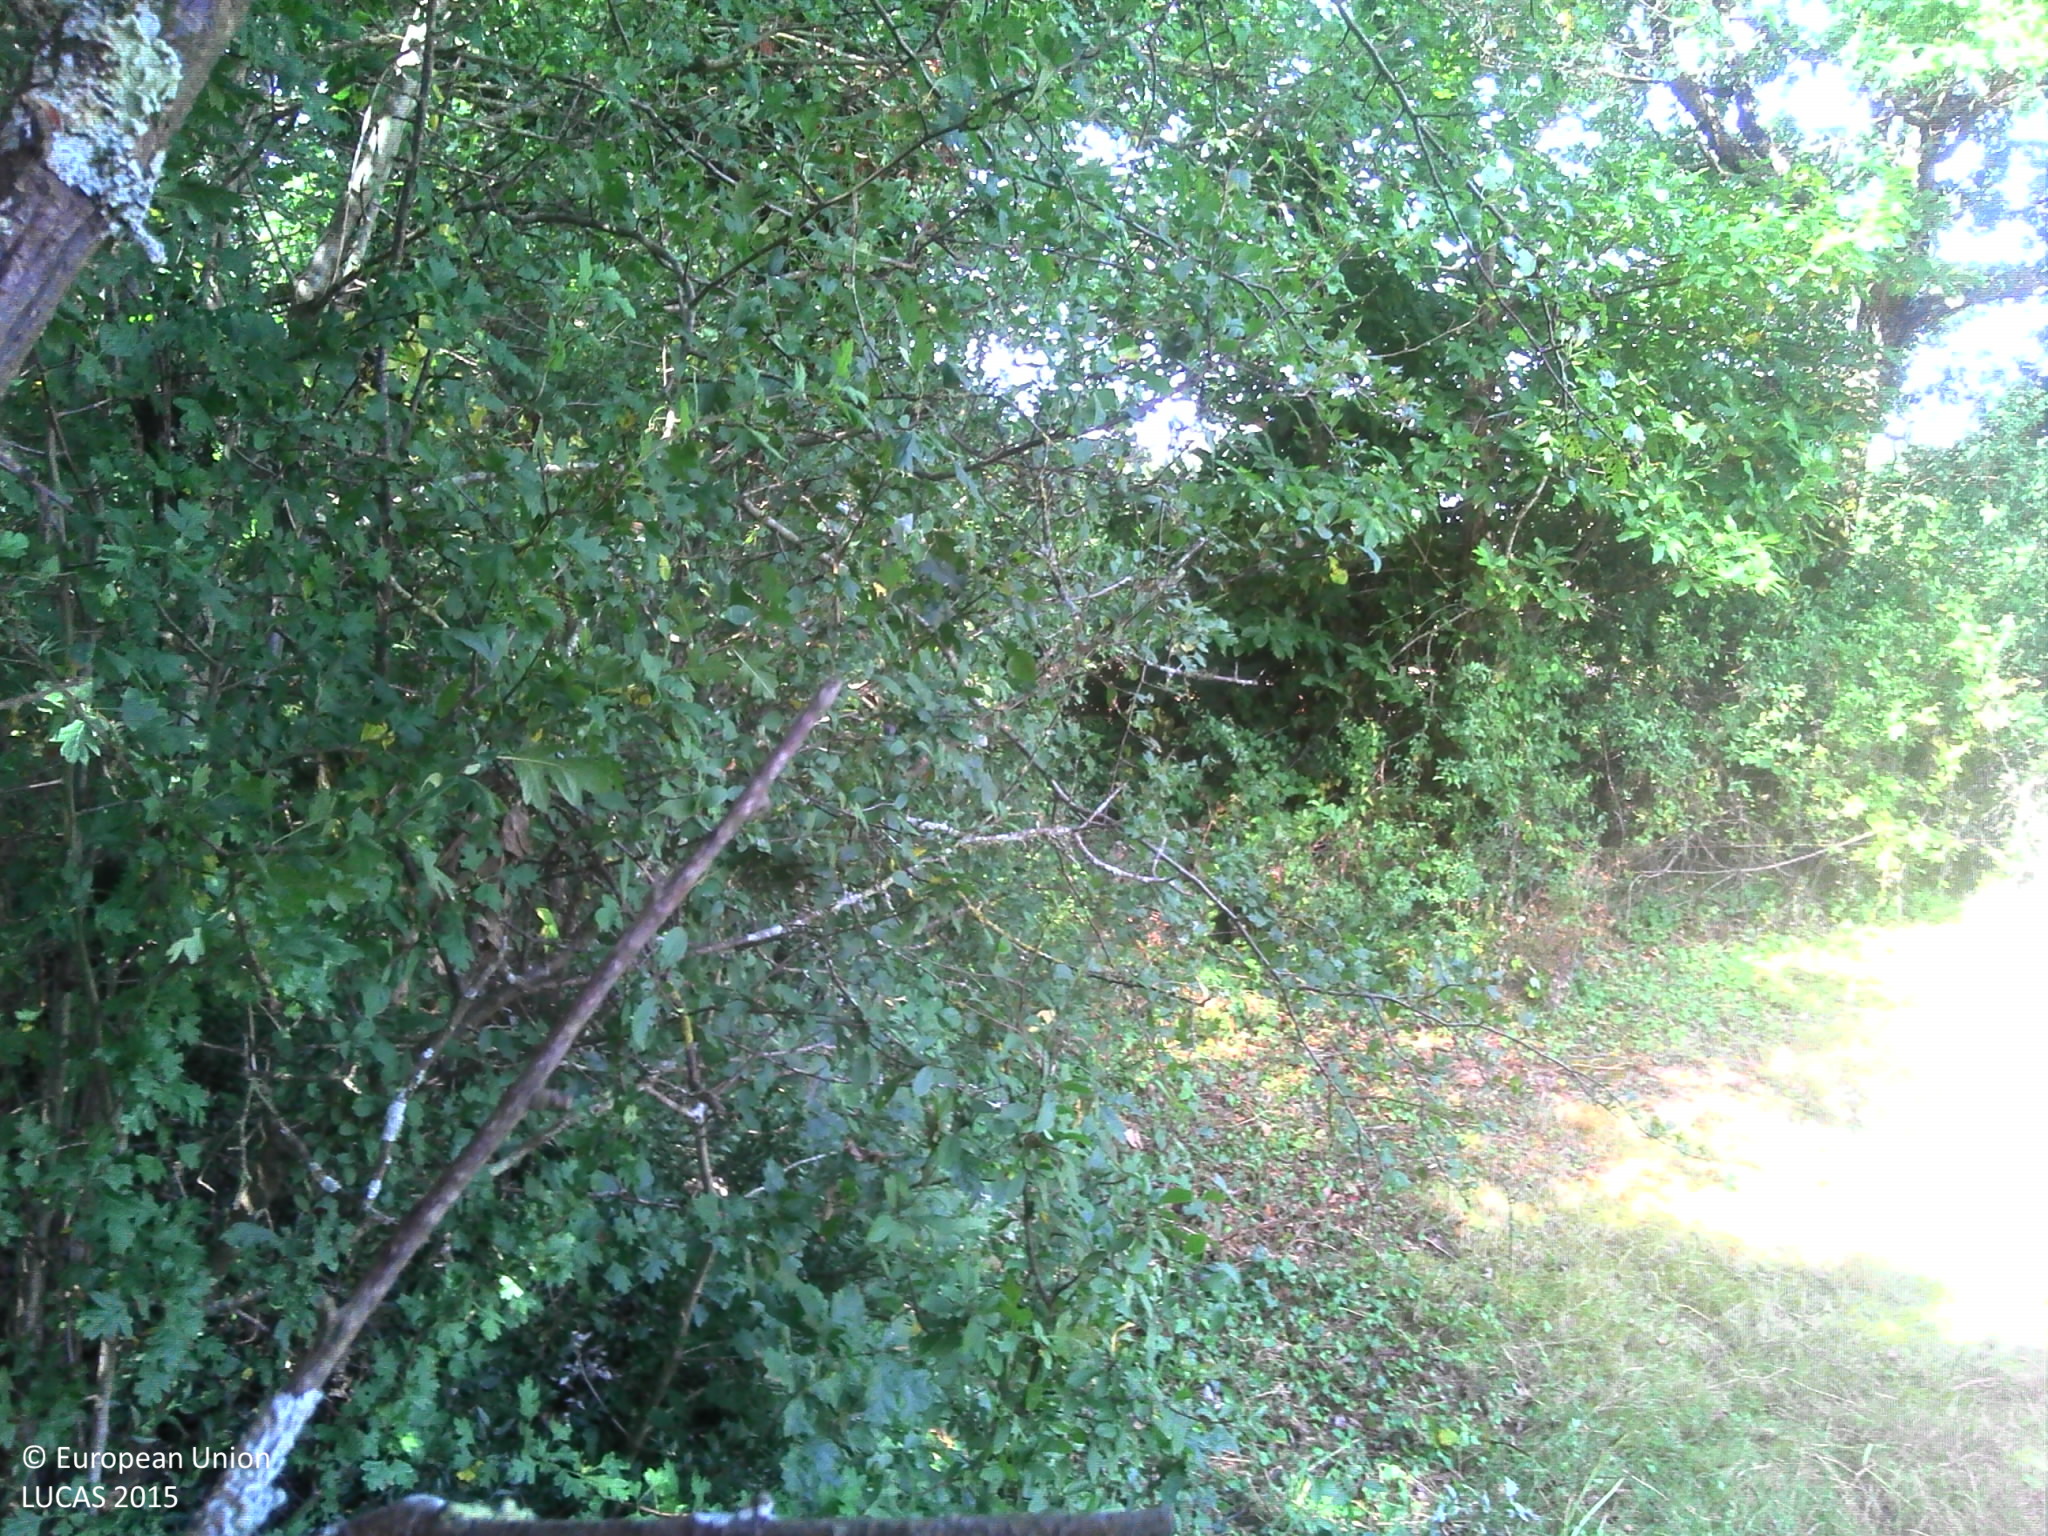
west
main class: Cropland
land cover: Temporary grasslands
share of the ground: > 75 %
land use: Agriculture (excluding fallow land and kitchen gardens)
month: July
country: FR
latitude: 46.5740
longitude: -1.5867
